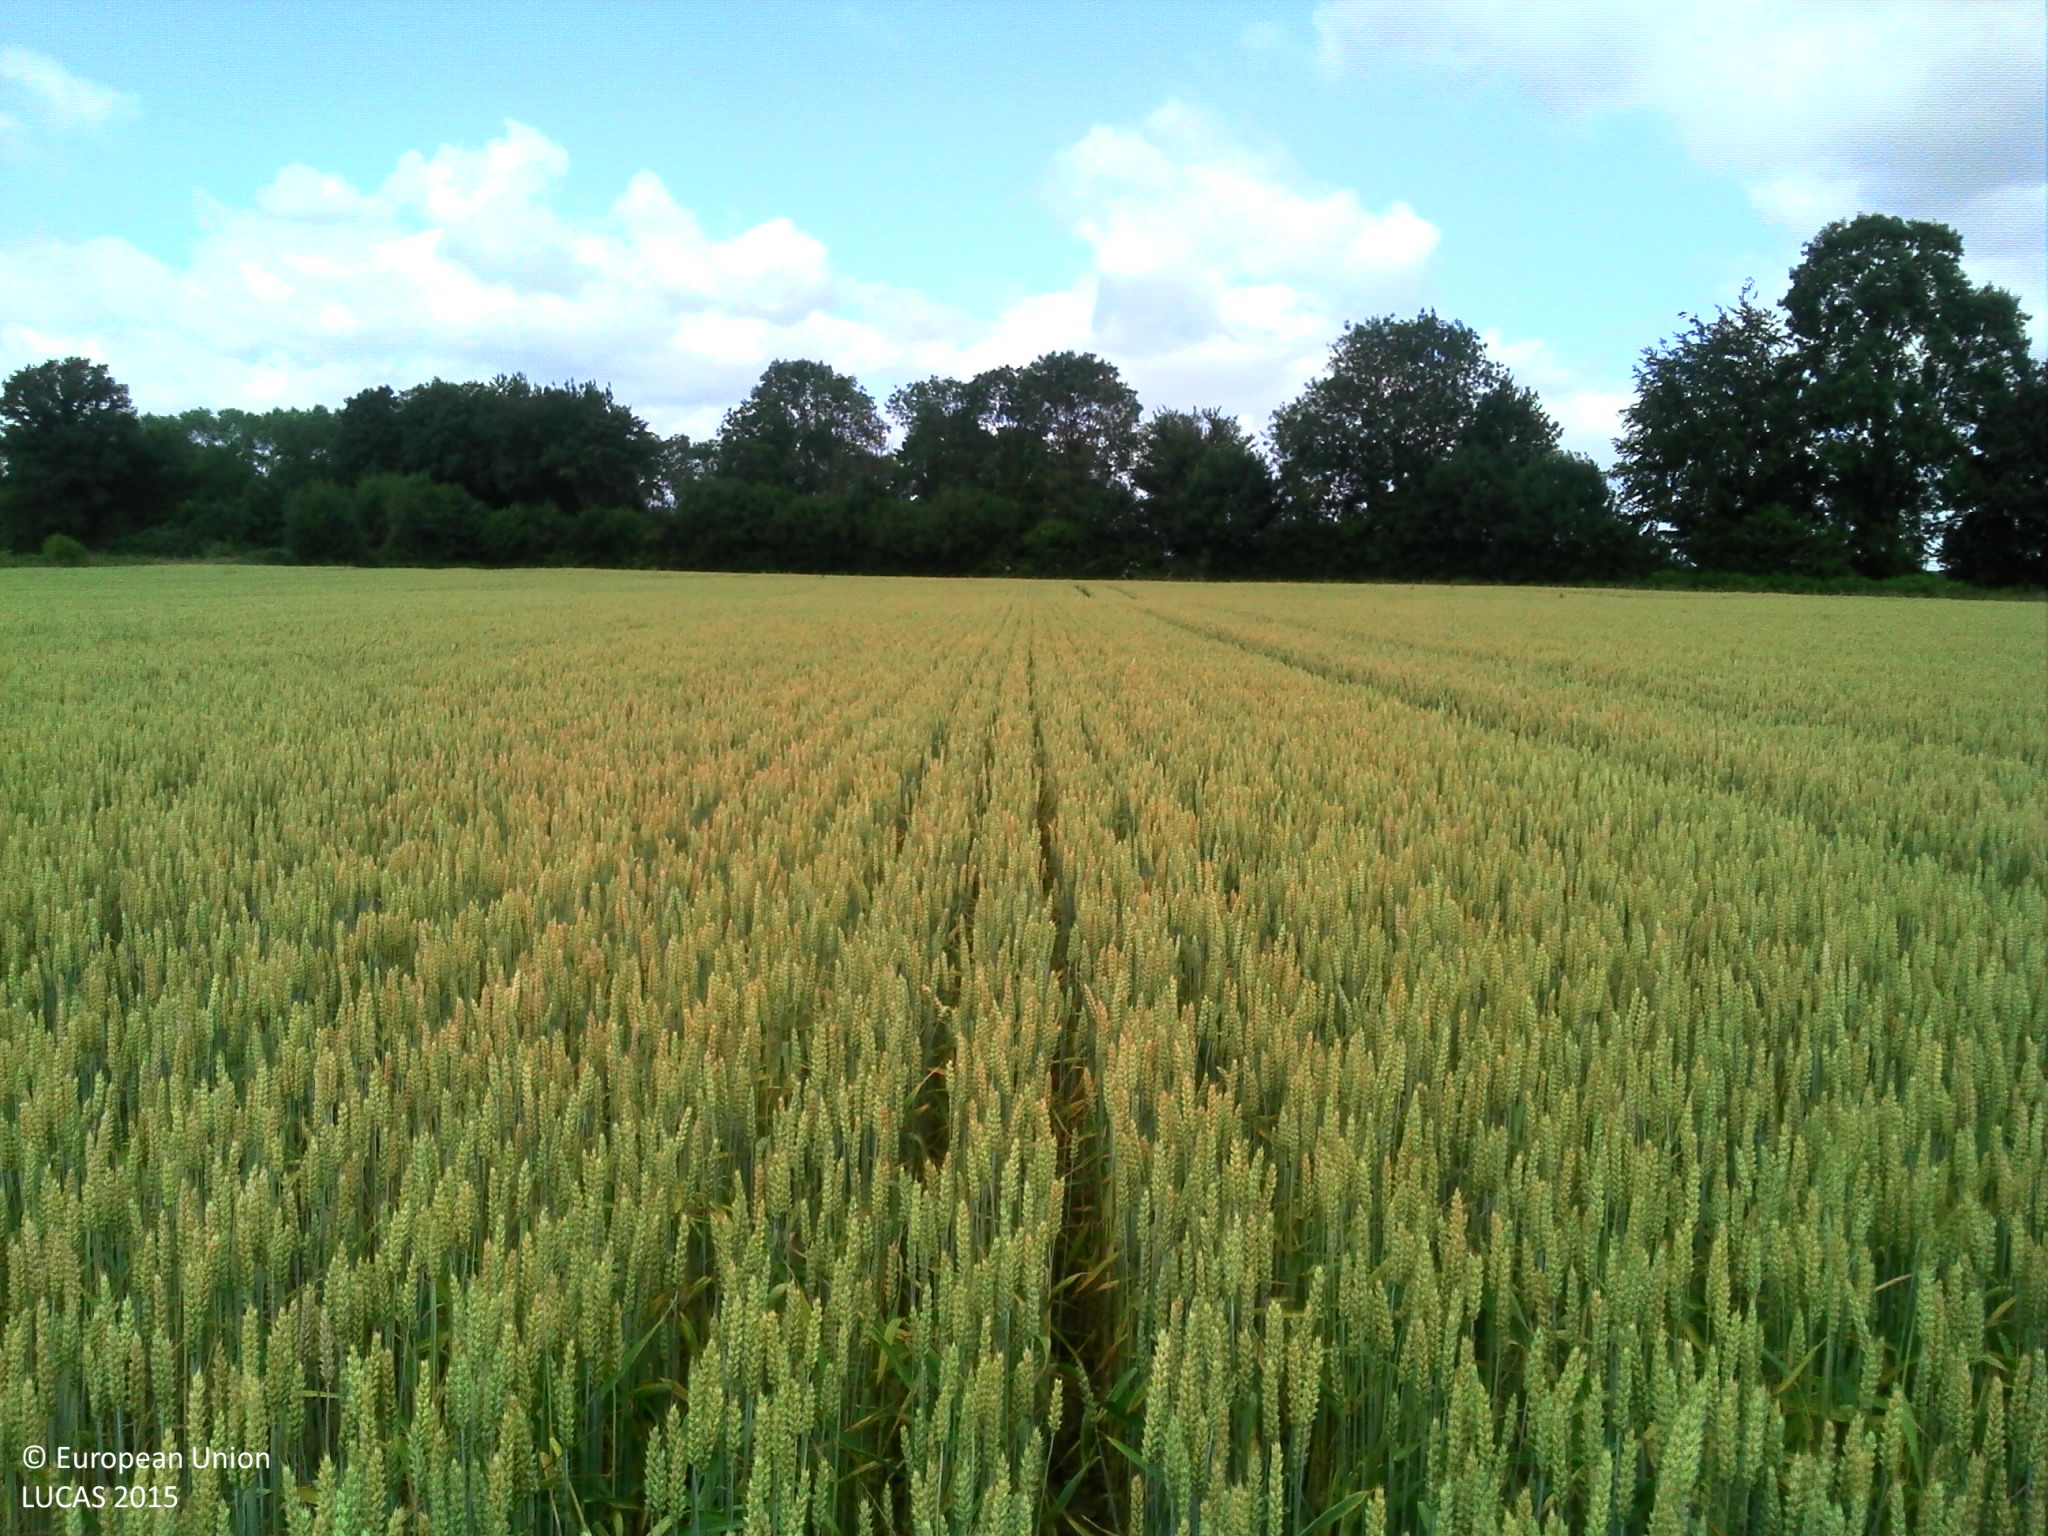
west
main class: Cropland
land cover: Common wheat
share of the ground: > 75 %
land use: Agriculture (excluding fallow land and kitchen gardens)
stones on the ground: < 10 %
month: July
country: FR
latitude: 49.0924
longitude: 0.4284
